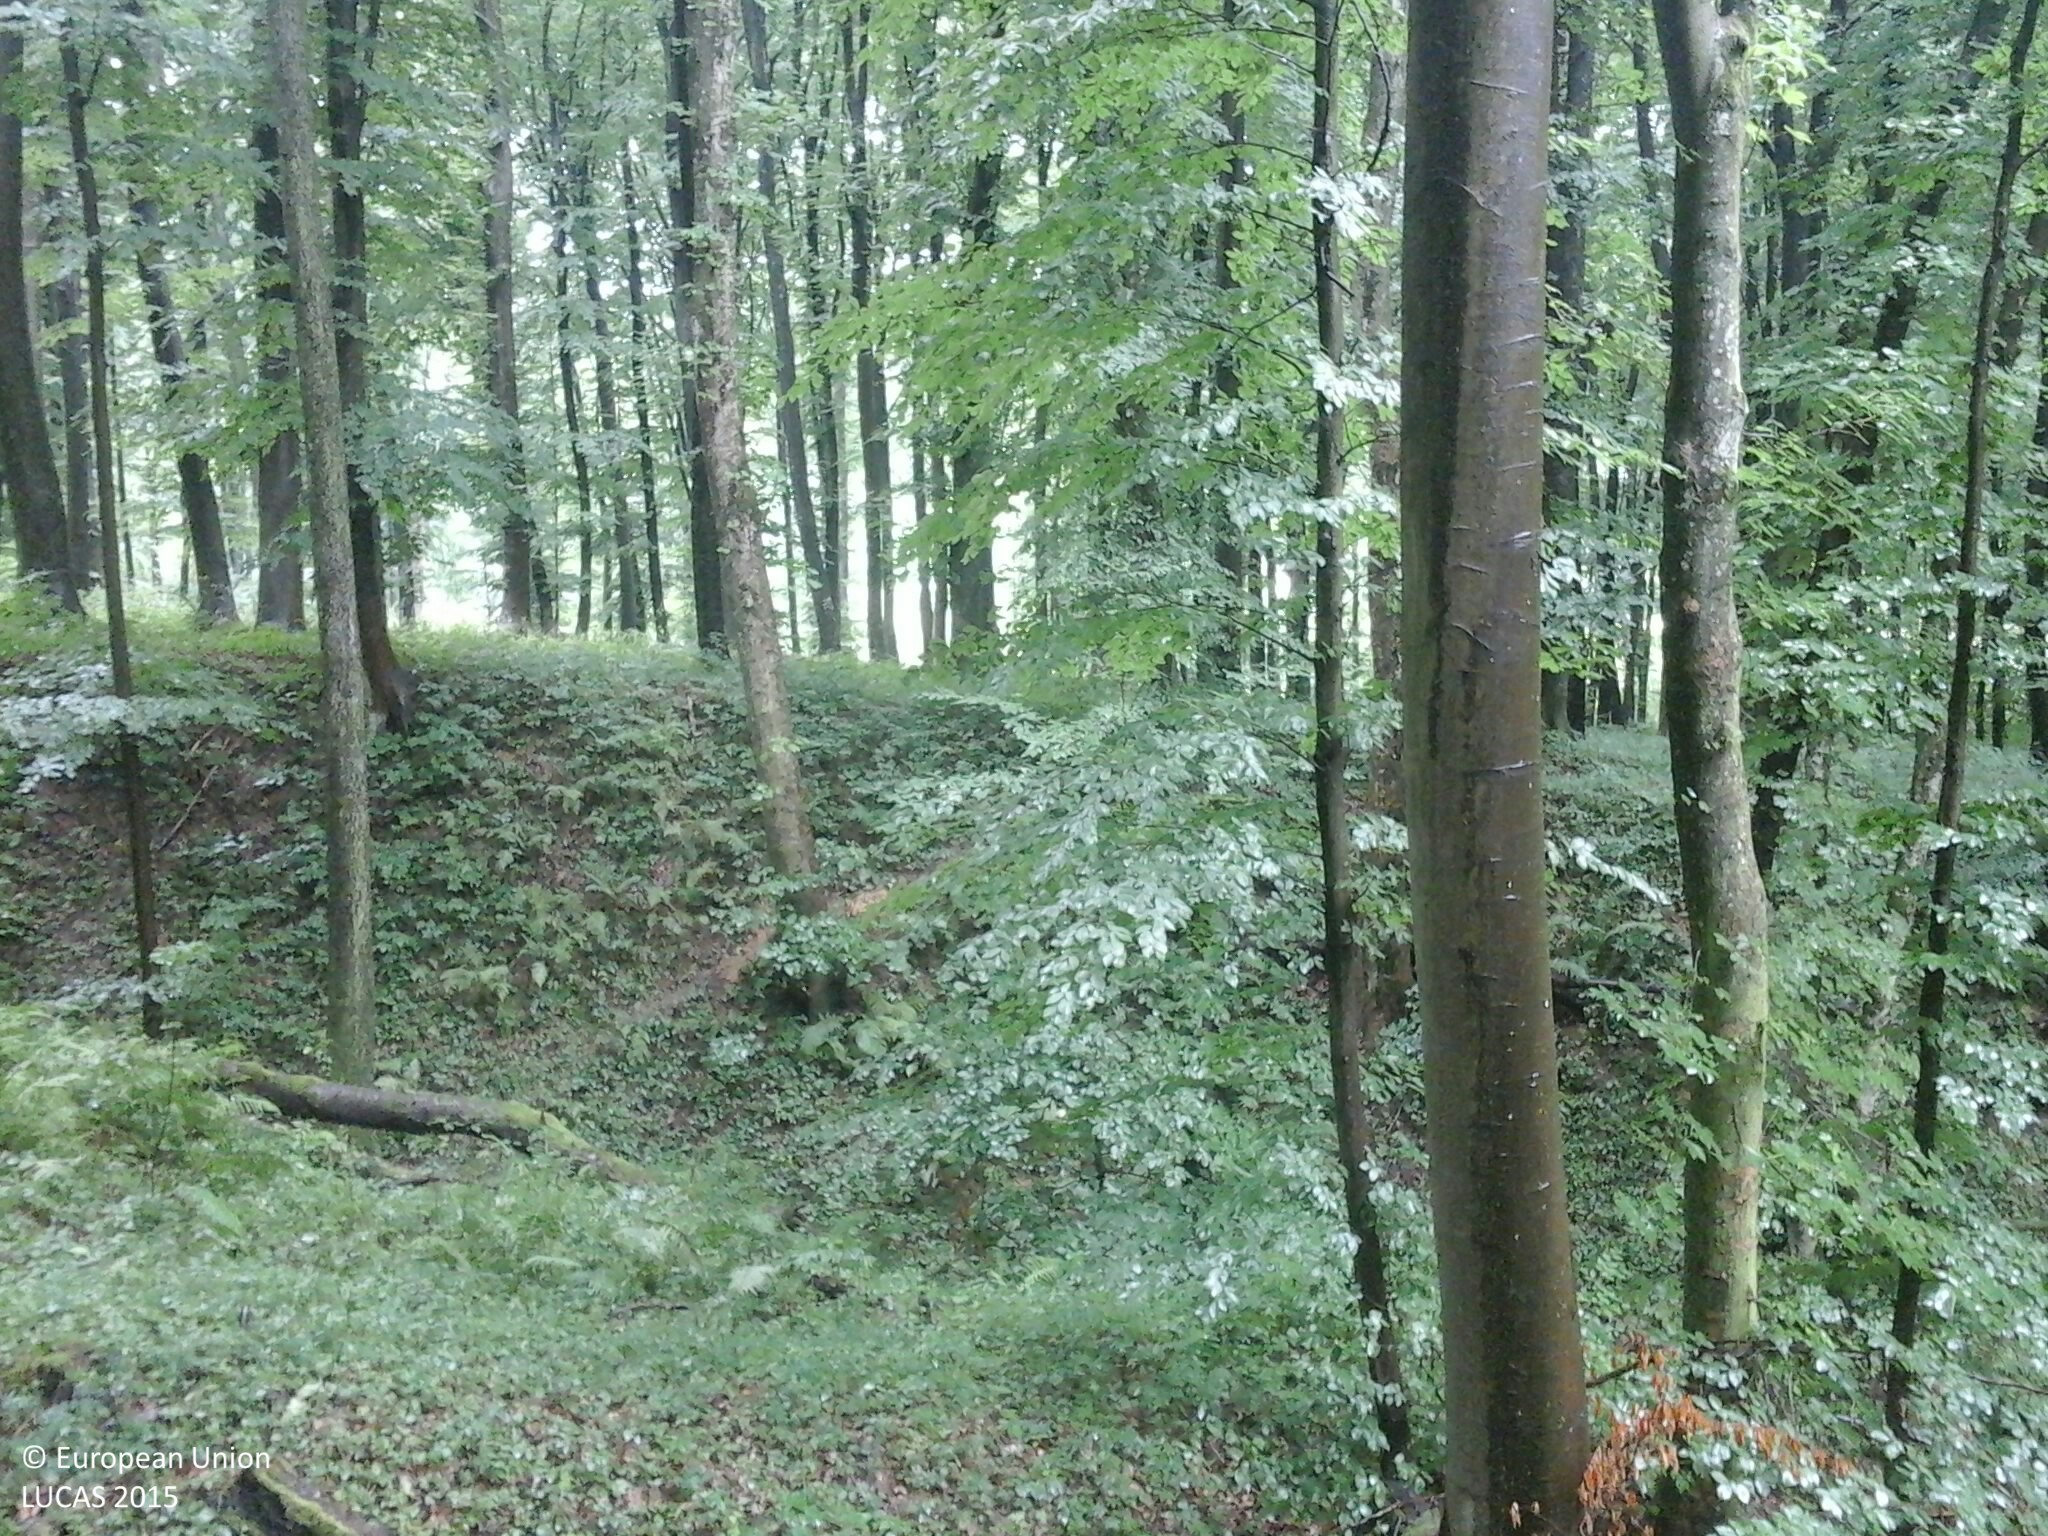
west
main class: Woodland
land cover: Broadleaved woodland
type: beech forest
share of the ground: > 75 %
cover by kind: broadleaved forest trees 80 %, shrubs 10 %, herbaceous plants 10 %
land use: Forestry
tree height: > 5 m
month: July
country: HU
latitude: 46.5862
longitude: 16.5138
